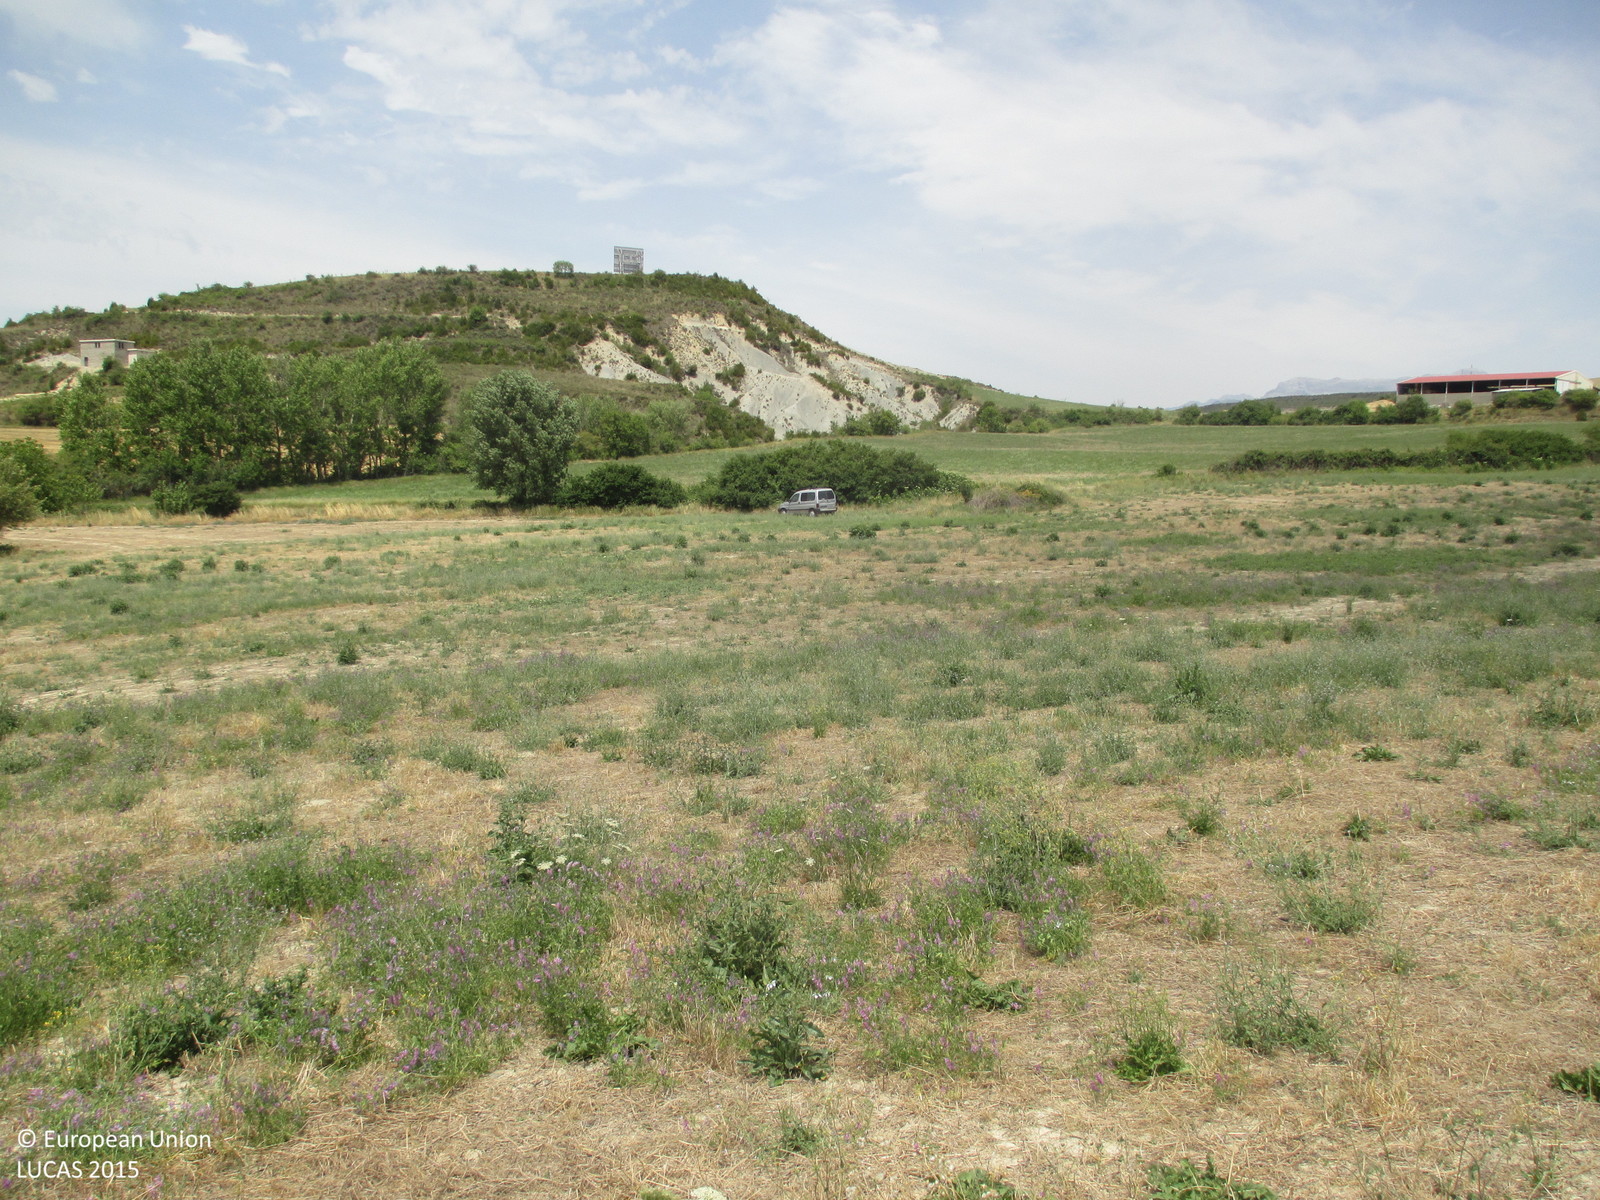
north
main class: Grassland
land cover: Spontaneously vegetated surfaces
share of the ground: > 75 %
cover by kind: herbaceous plants 100 %
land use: Fallow land
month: July
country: ES
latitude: 42.5062
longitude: -0.3328
